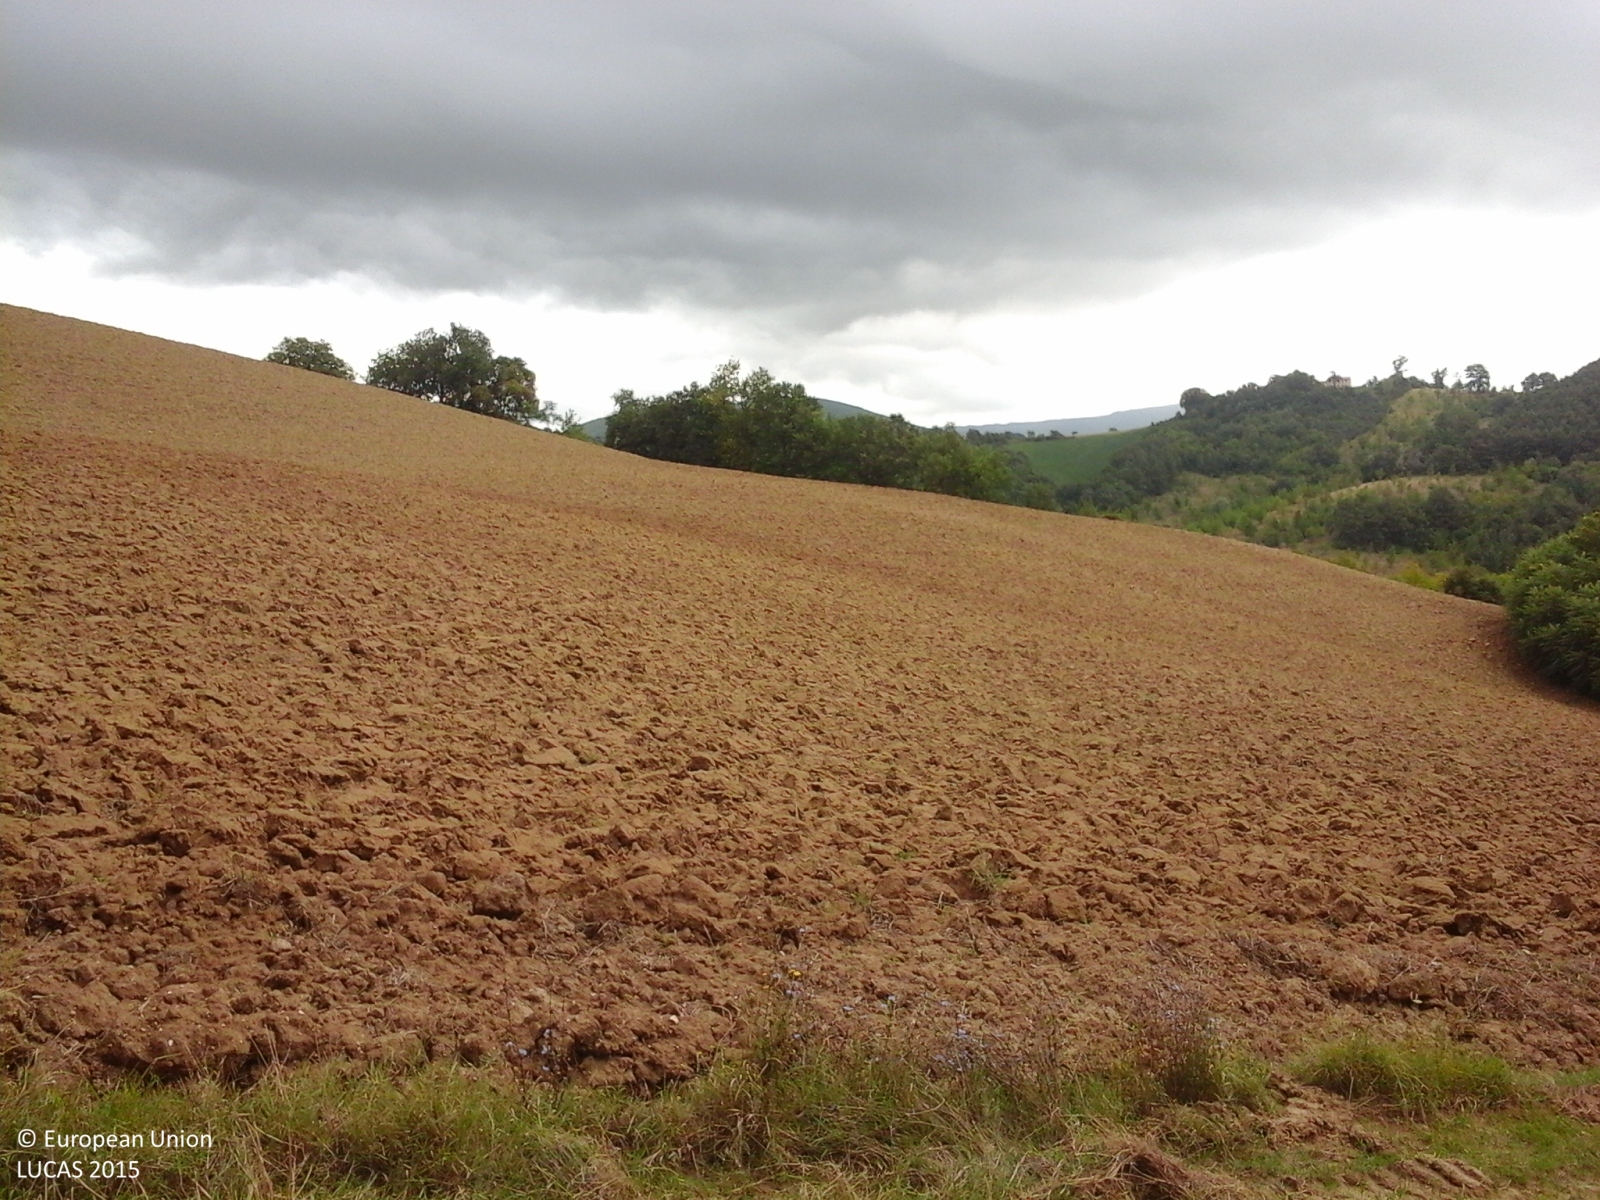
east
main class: Woodland
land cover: Broadleaved woodland
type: thermophilous deciduous forest
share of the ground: 50 - 75 %
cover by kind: broadleaved forest trees 95 %, shrubs 5 %
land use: Forestry
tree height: > 5 m
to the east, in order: Broadleaved woodland; Grass margins; Tracks; Durum wheat; Shrubland with sparse tree cover
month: August
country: IT
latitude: 43.3462
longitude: 13.1376
